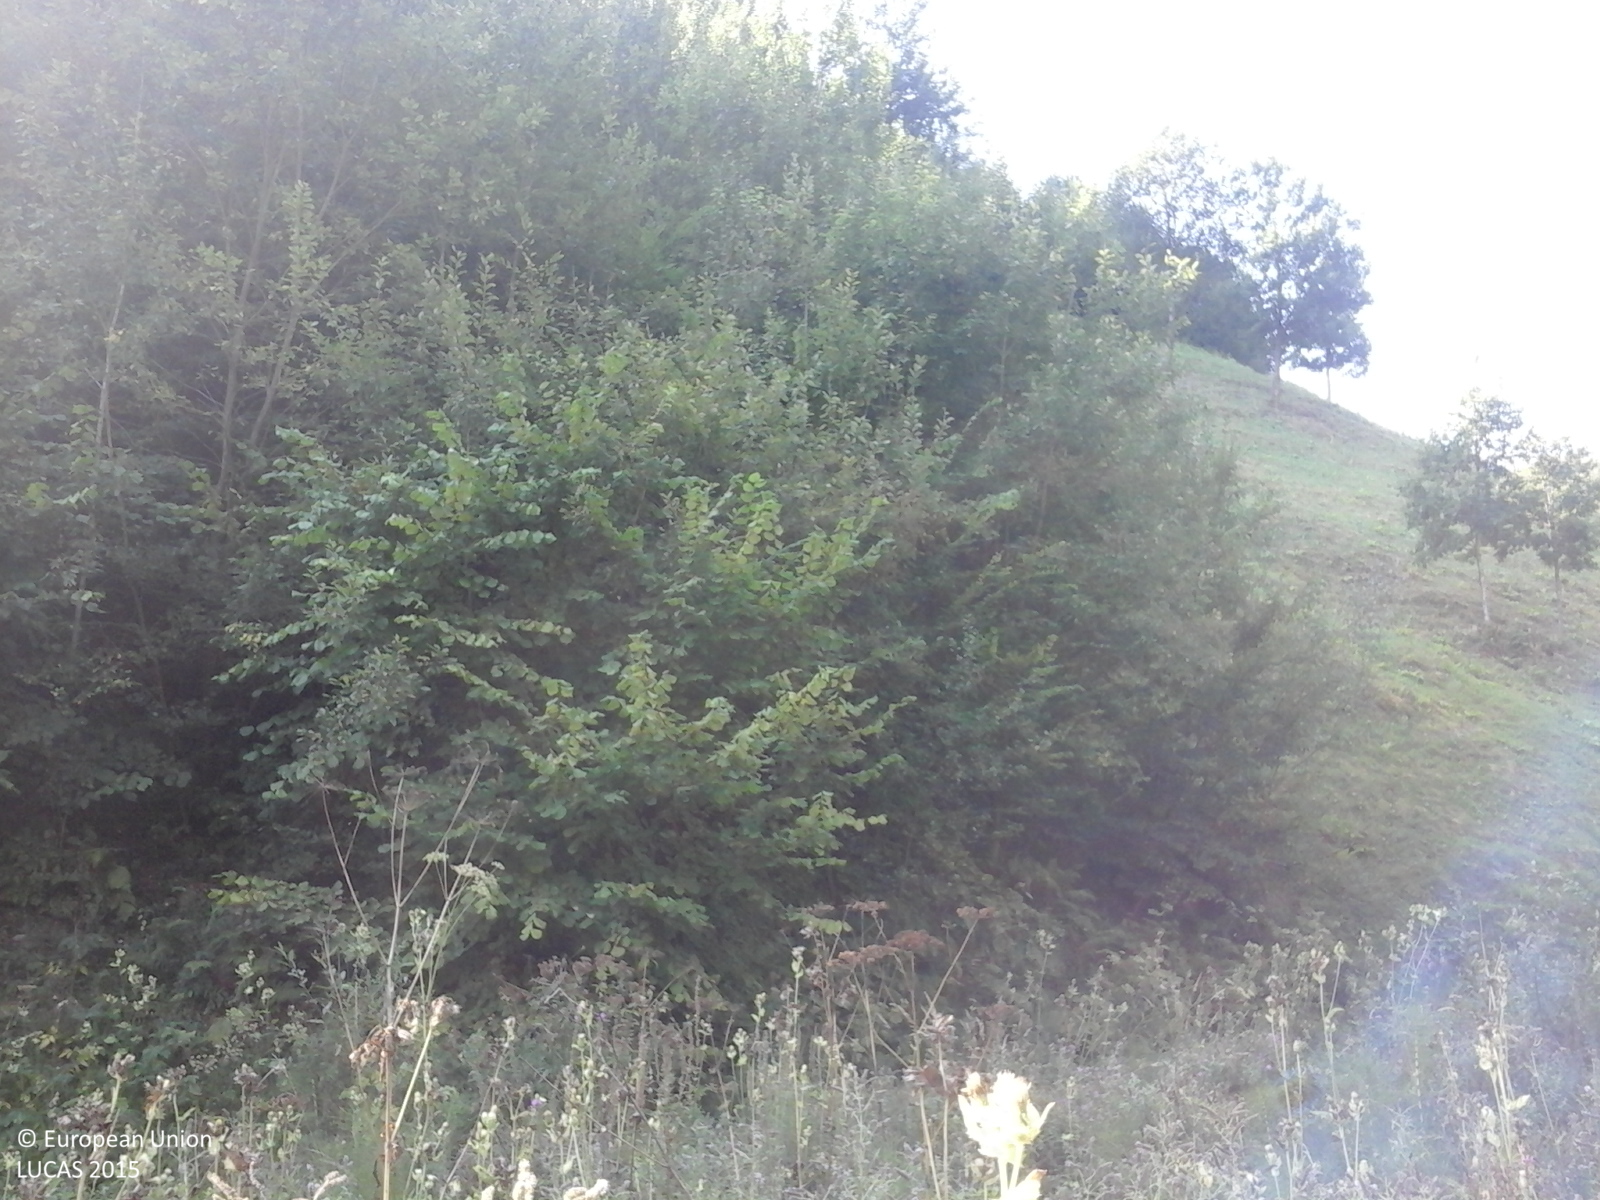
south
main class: Grassland
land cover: Grassland with sparse tree/shrub cover
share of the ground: > 75 %
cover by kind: herbaceous plants 85 %, shrubs 10 %, broadleaved forest trees 5 %
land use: Fallow land
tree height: < 5 m
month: September
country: RO
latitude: 47.3662
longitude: 24.3778
